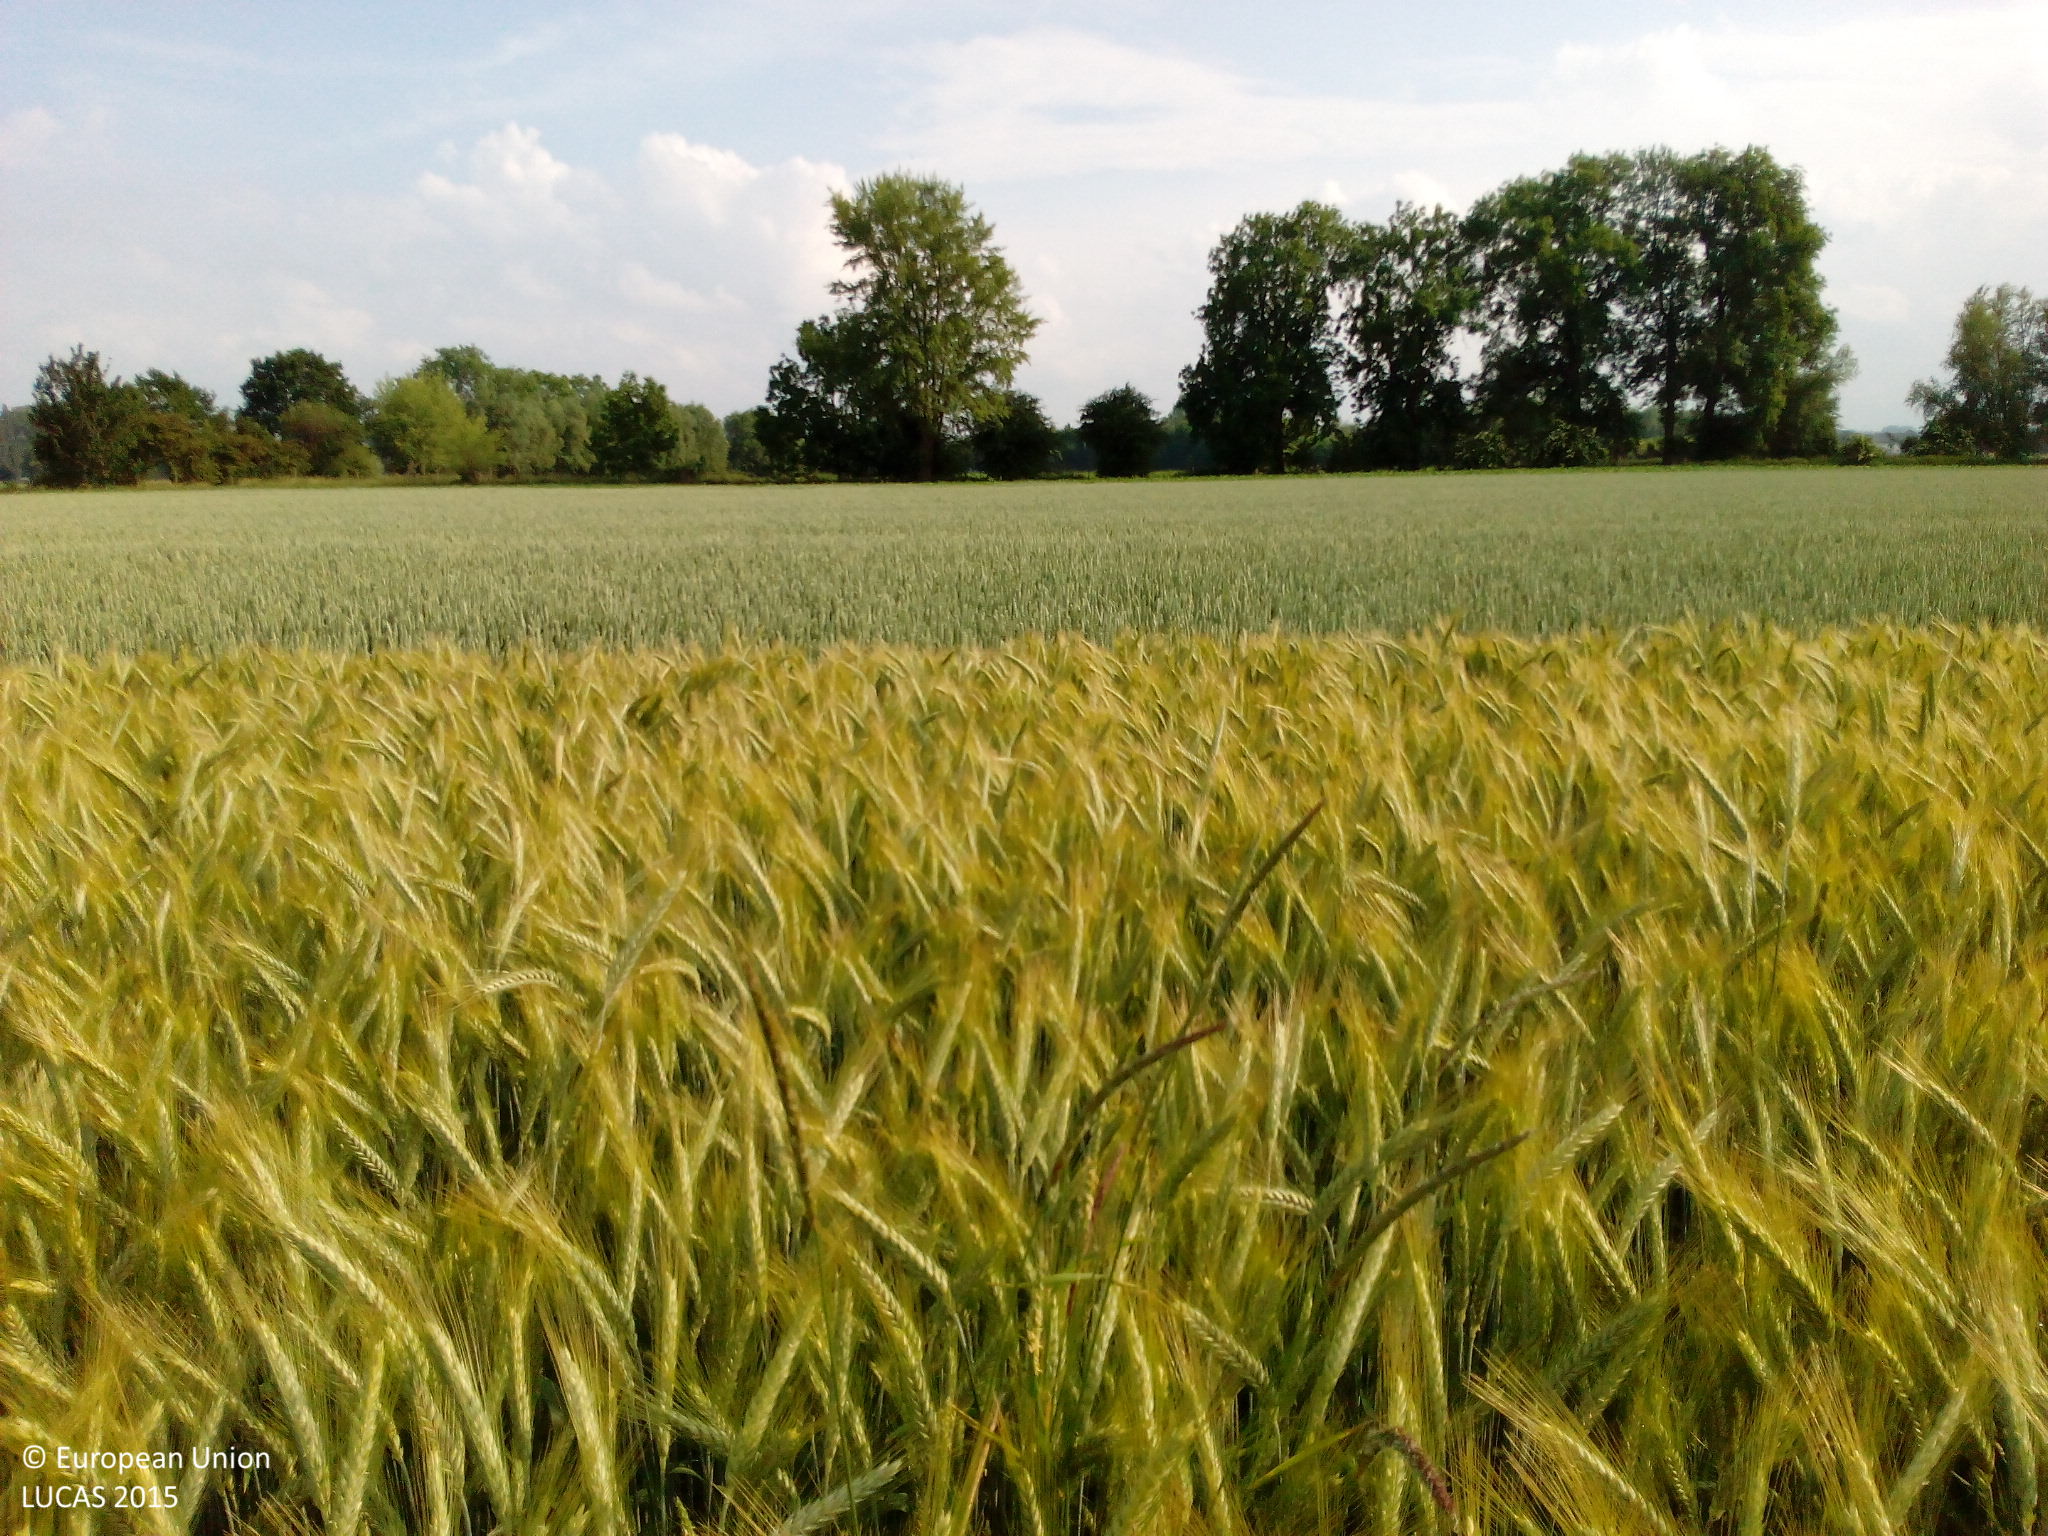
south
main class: Cropland
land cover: Barley
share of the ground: > 75 %
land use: Agriculture (excluding fallow land and kitchen gardens)
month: June
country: DE
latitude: 51.6842
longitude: 8.4527
